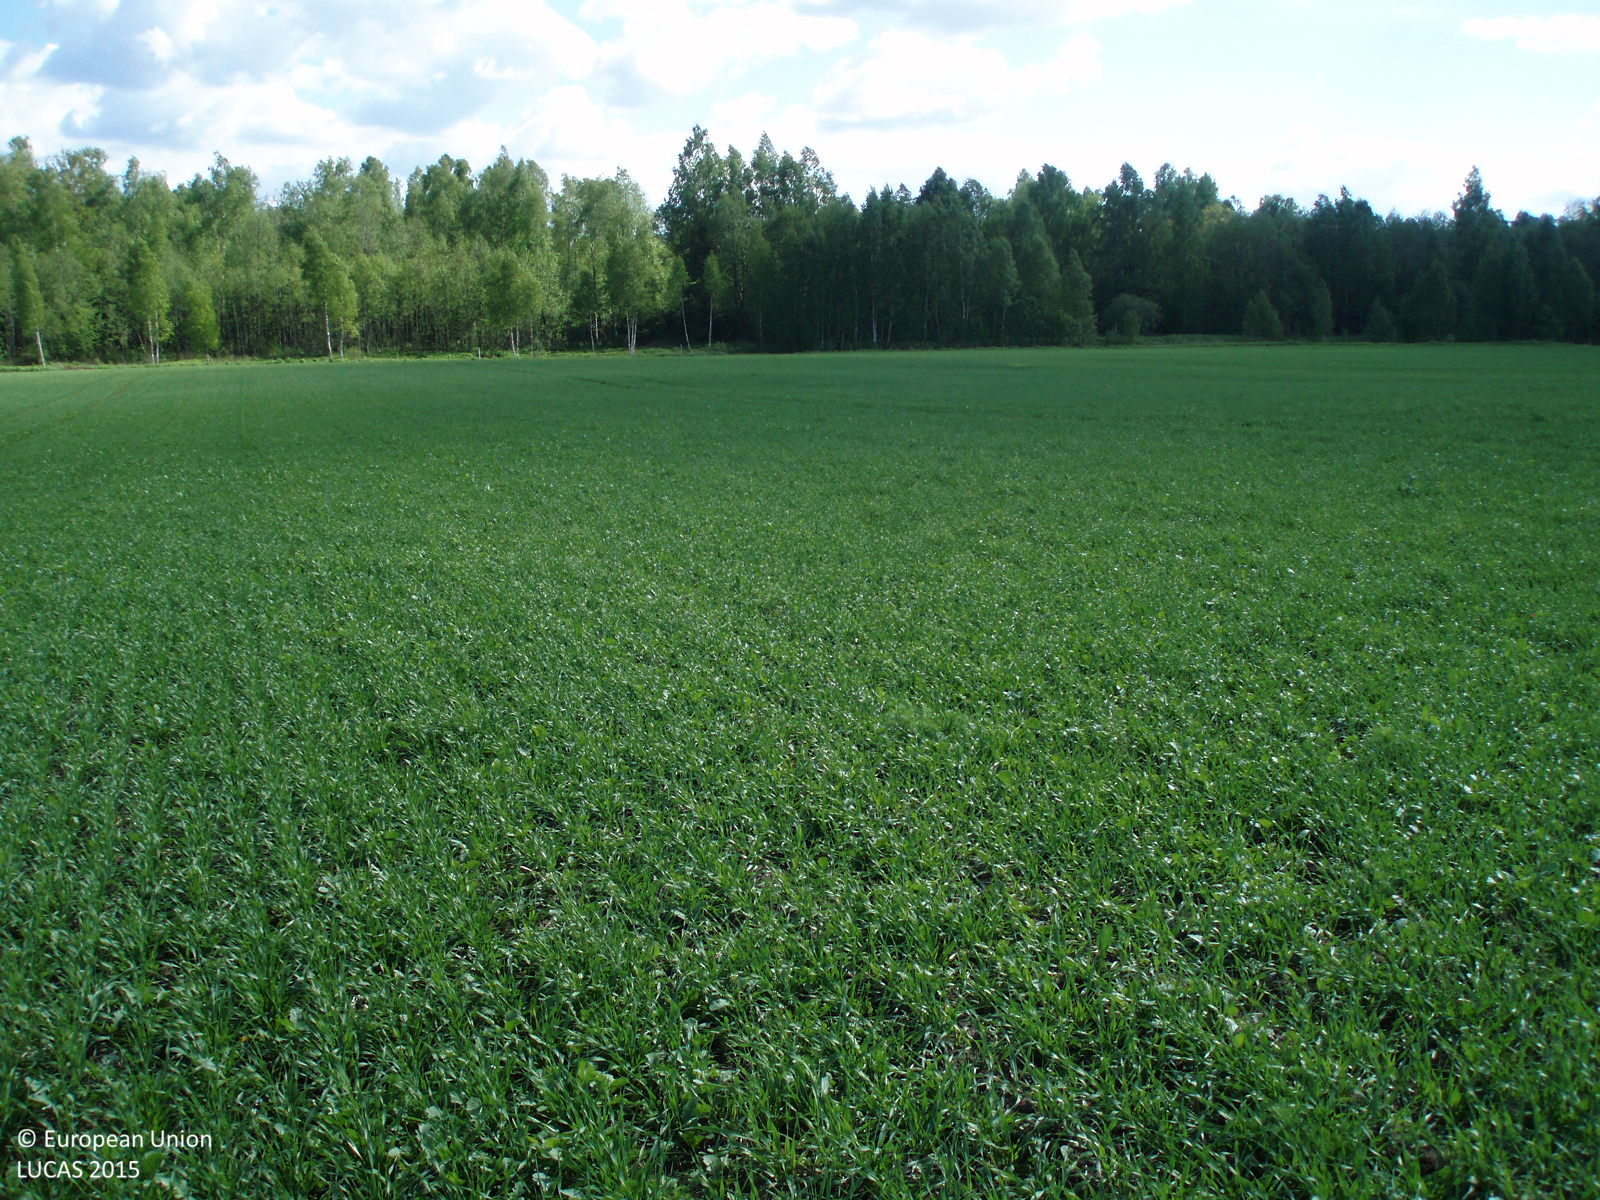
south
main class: Cropland
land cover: Rape and turnip rape
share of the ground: 50 - 75 %
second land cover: Barley
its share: 25 - 50 %
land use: Agriculture (excluding fallow land and kitchen gardens)
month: May
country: LT
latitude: 56.2705
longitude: 23.0012
